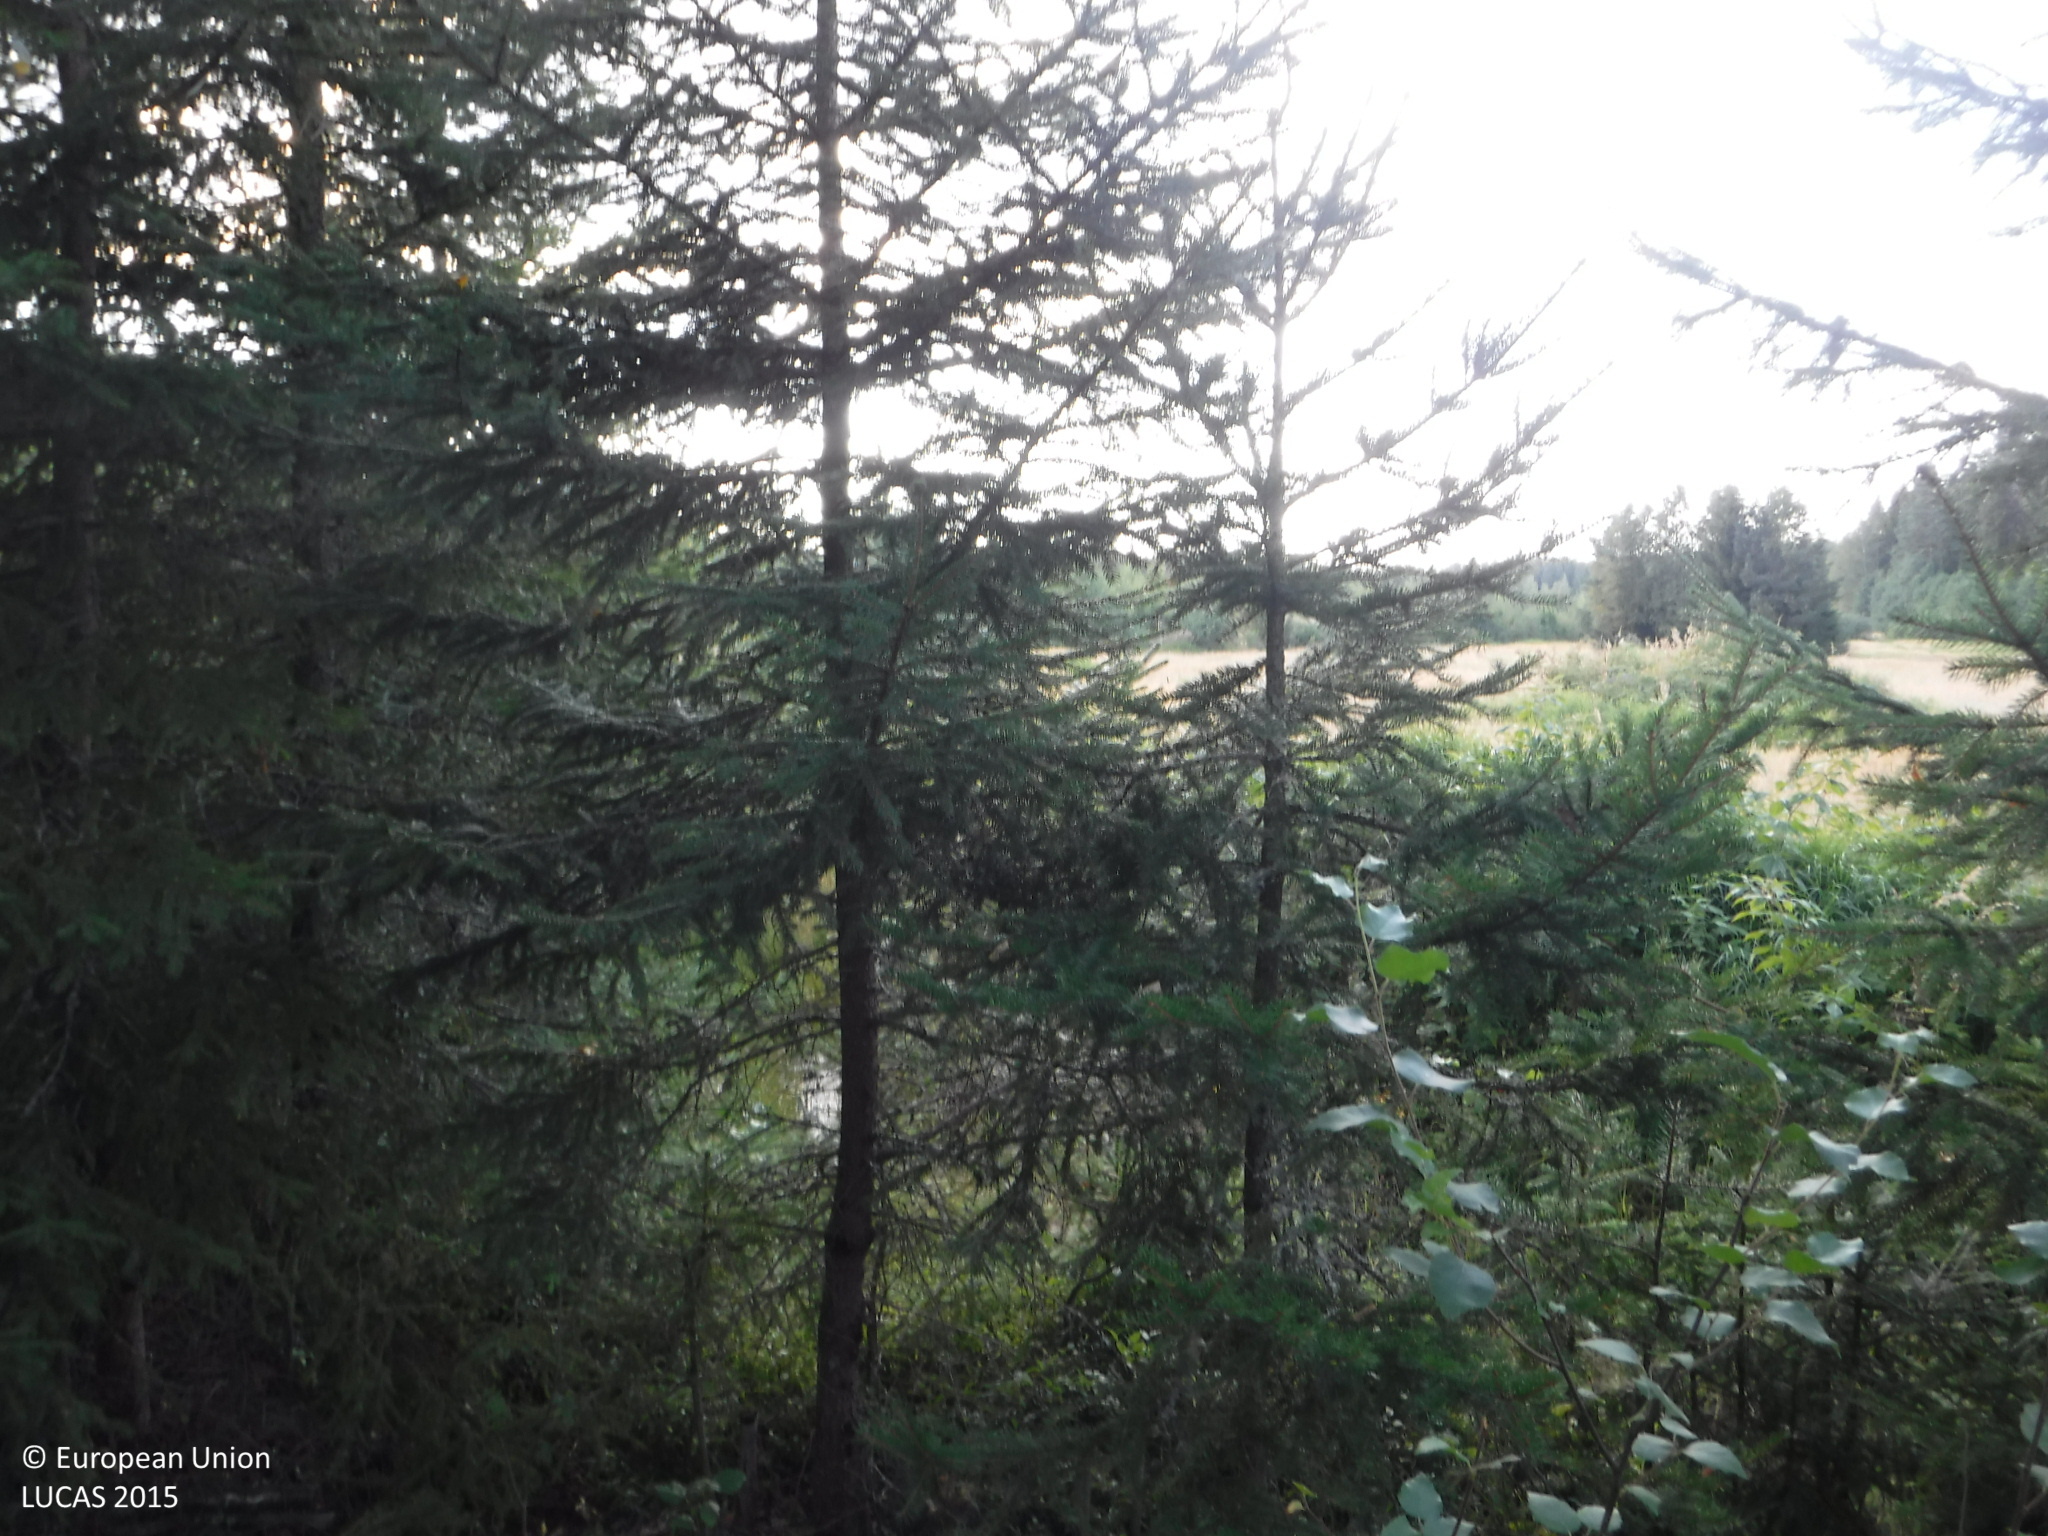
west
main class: Woodland
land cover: Spruce dominated mixed woodland
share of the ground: 50 - 75 %
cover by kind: coniferous forest trees 40 %, broadleaved forest trees 30 %, shrubs 10 %, lichens and mosses 10 %
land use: Forestry
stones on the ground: < 10 %
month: August
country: FI
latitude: 61.1820
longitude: 23.0362
